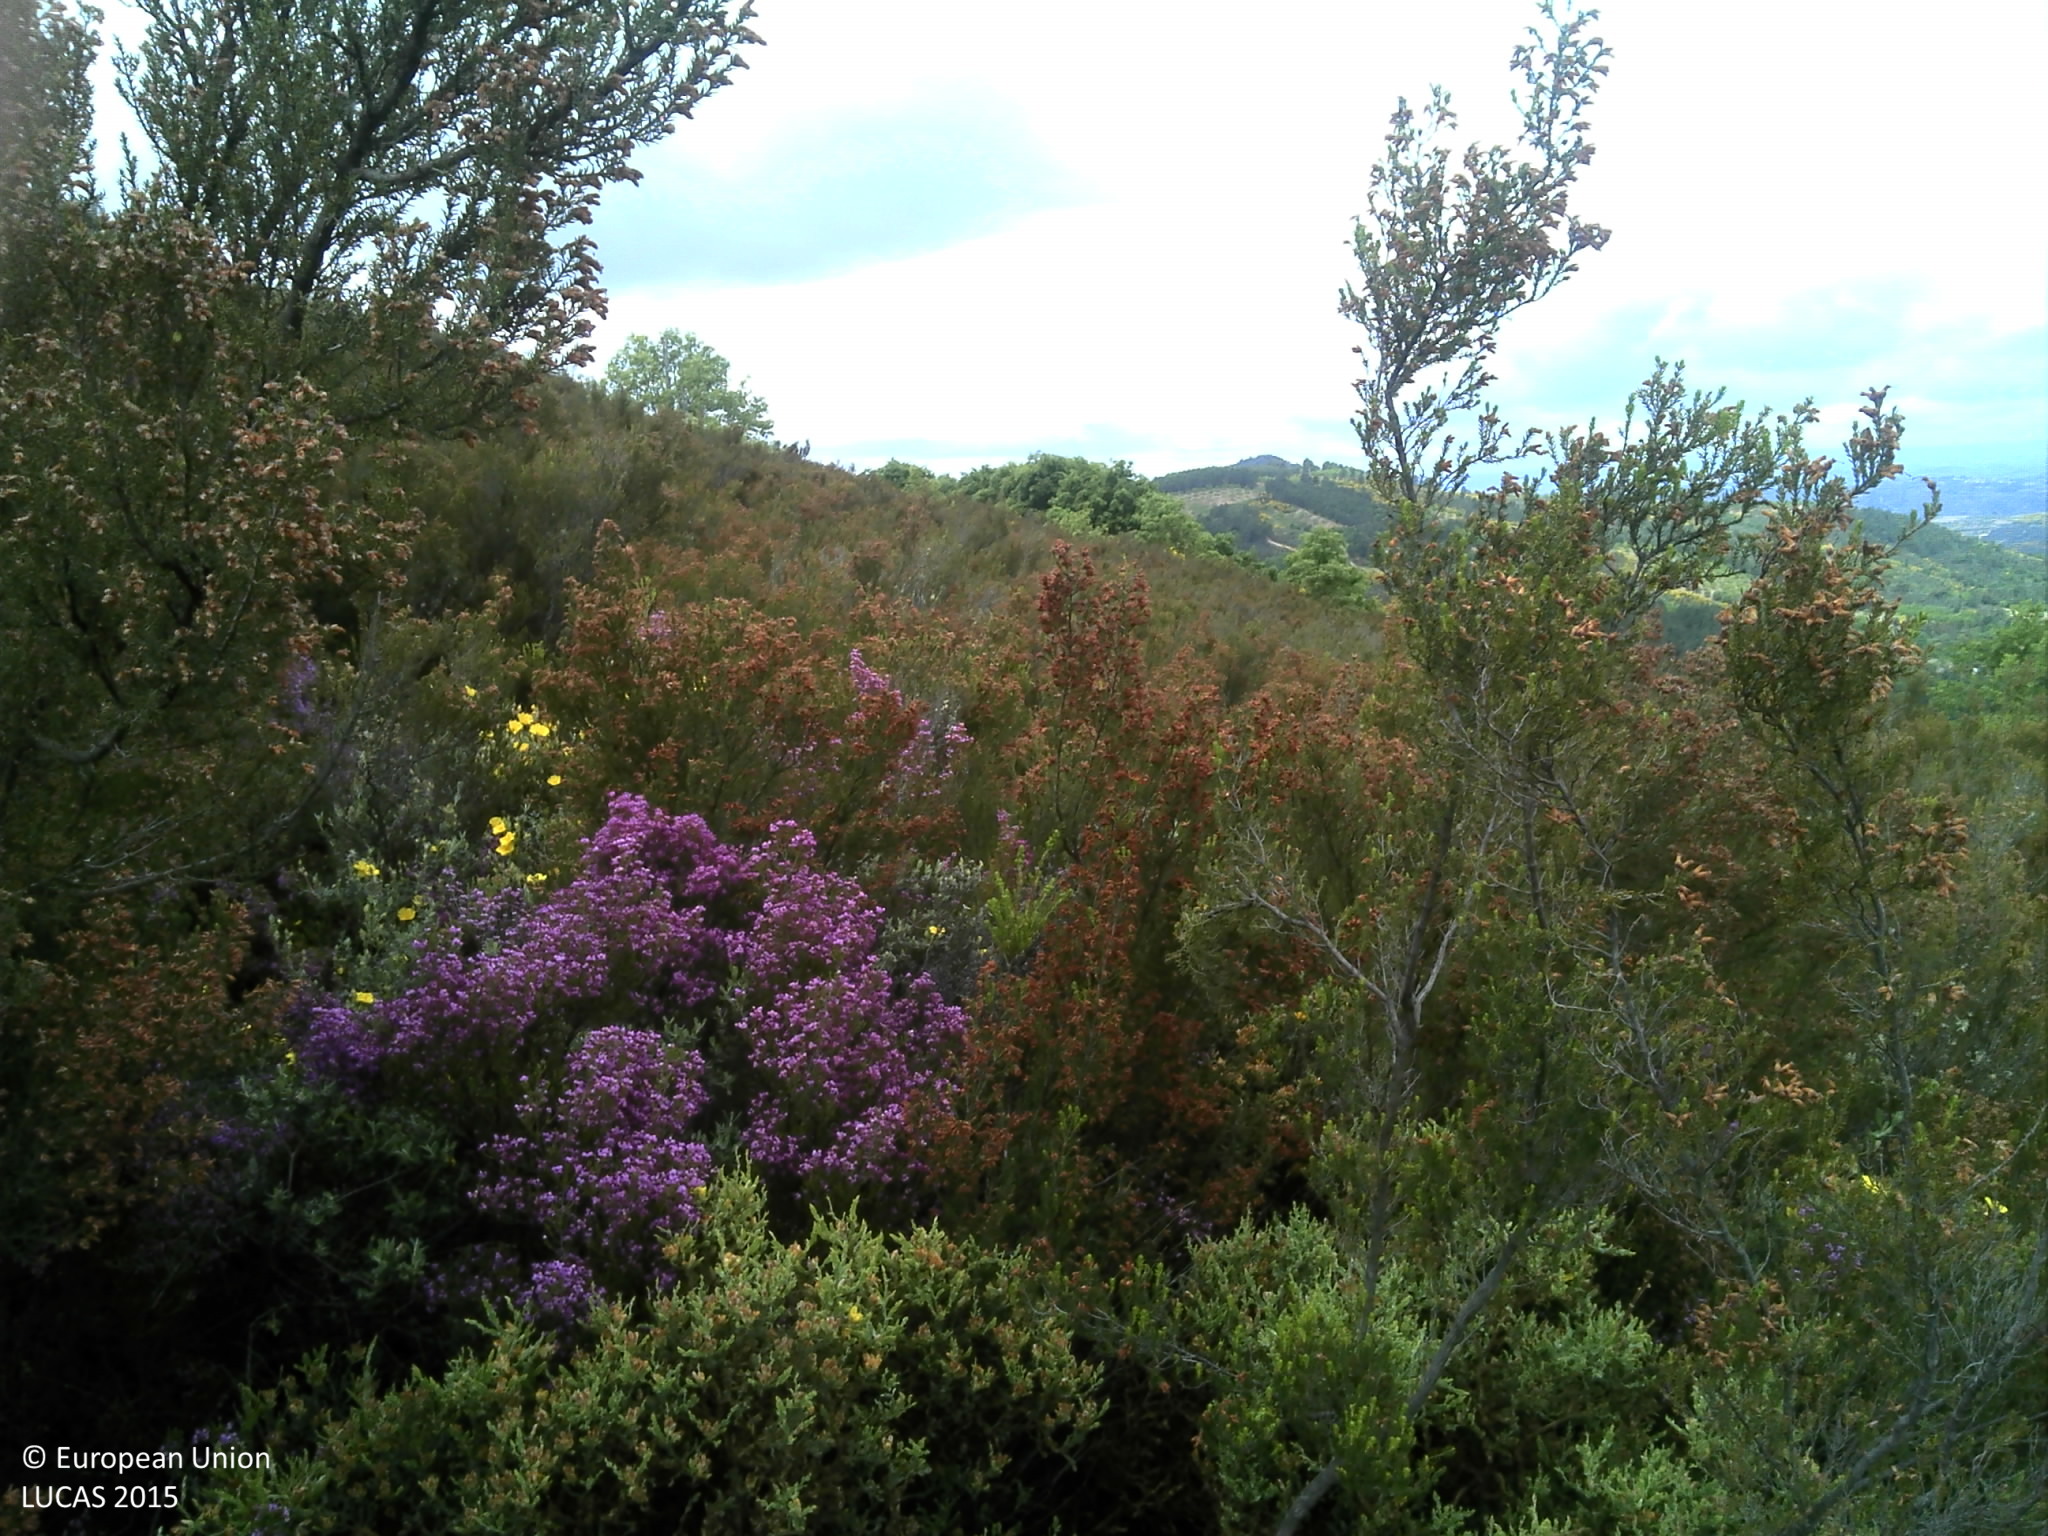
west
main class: Shrubland
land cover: Shrubland with sparse tree cover
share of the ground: > 75 %
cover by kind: shrubs 90 %, broadleaved forest trees 5 %, unconsolidated bare surface 5 %
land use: Abandoned areas
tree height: > 5 m
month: May
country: PT
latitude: 41.6178
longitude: -6.9529
